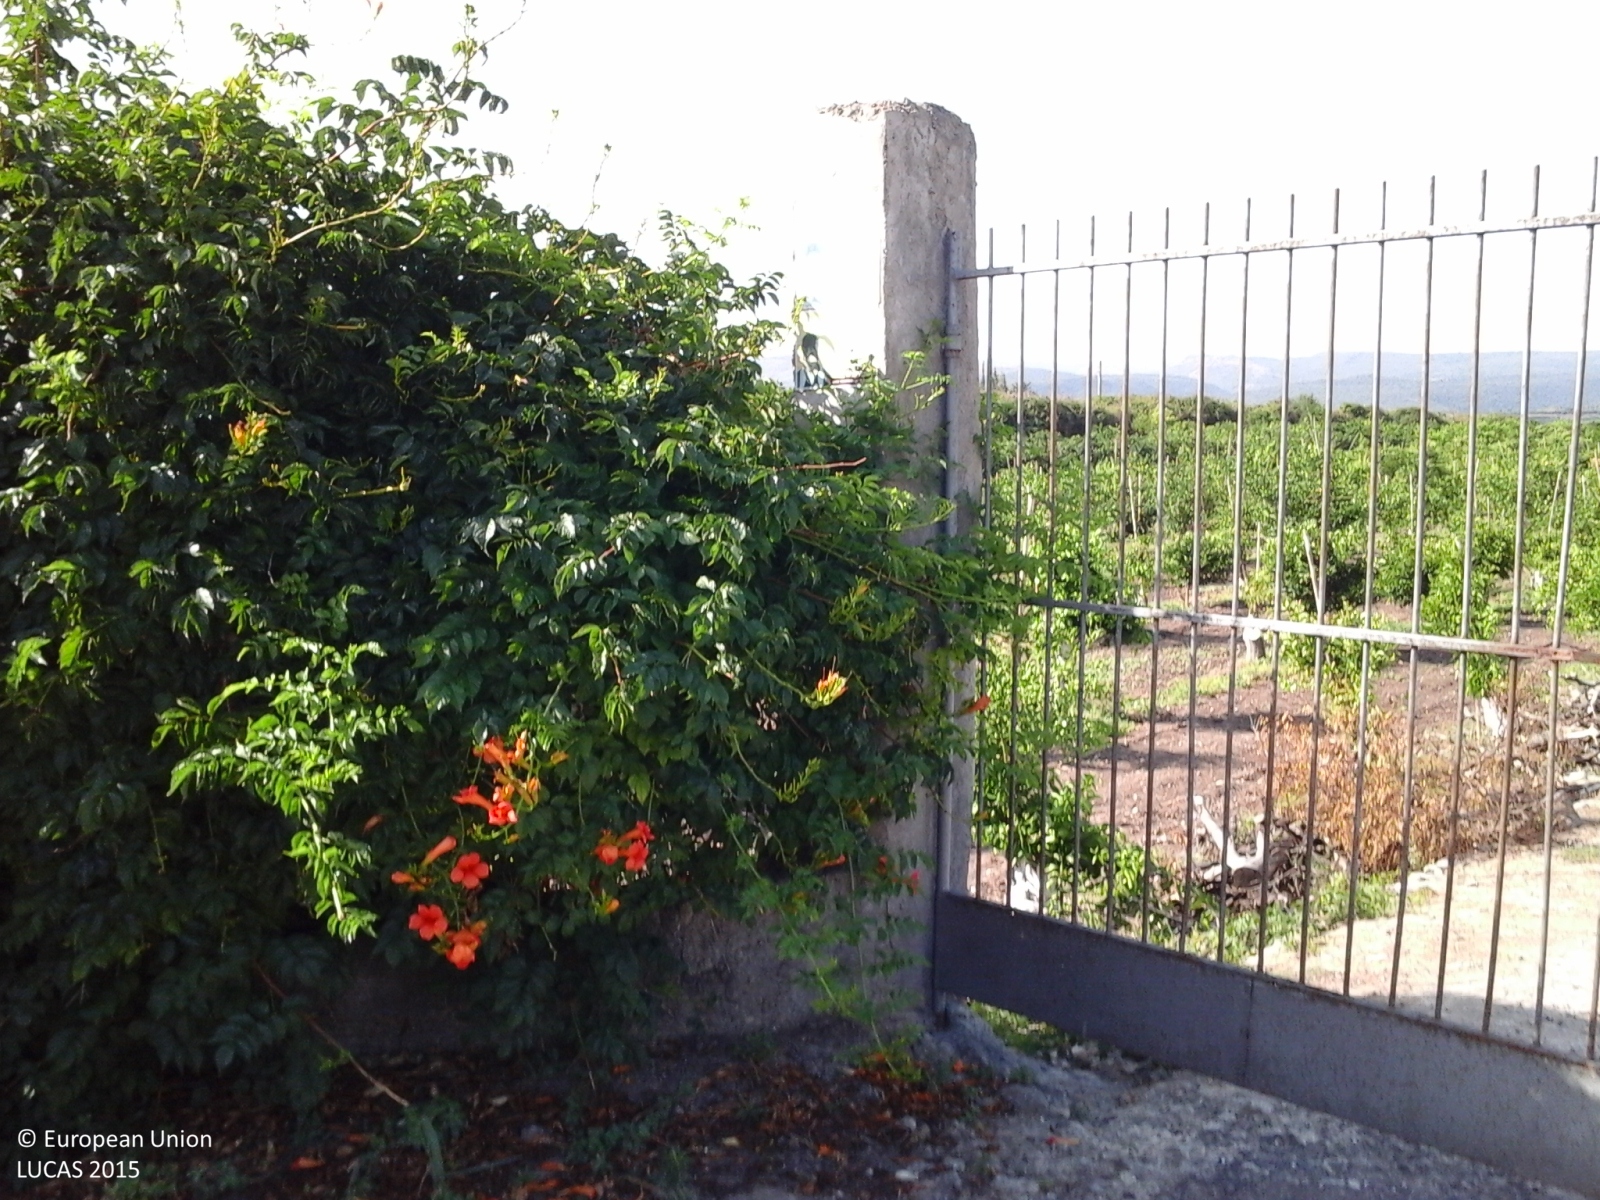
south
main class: Cropland
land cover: Oranges
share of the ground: > 75 %
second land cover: Spontaneously vegetated surfaces
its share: > 75 %
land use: Agriculture (excluding fallow land and kitchen gardens)
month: August
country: IT
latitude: 37.2217
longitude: 14.8880
